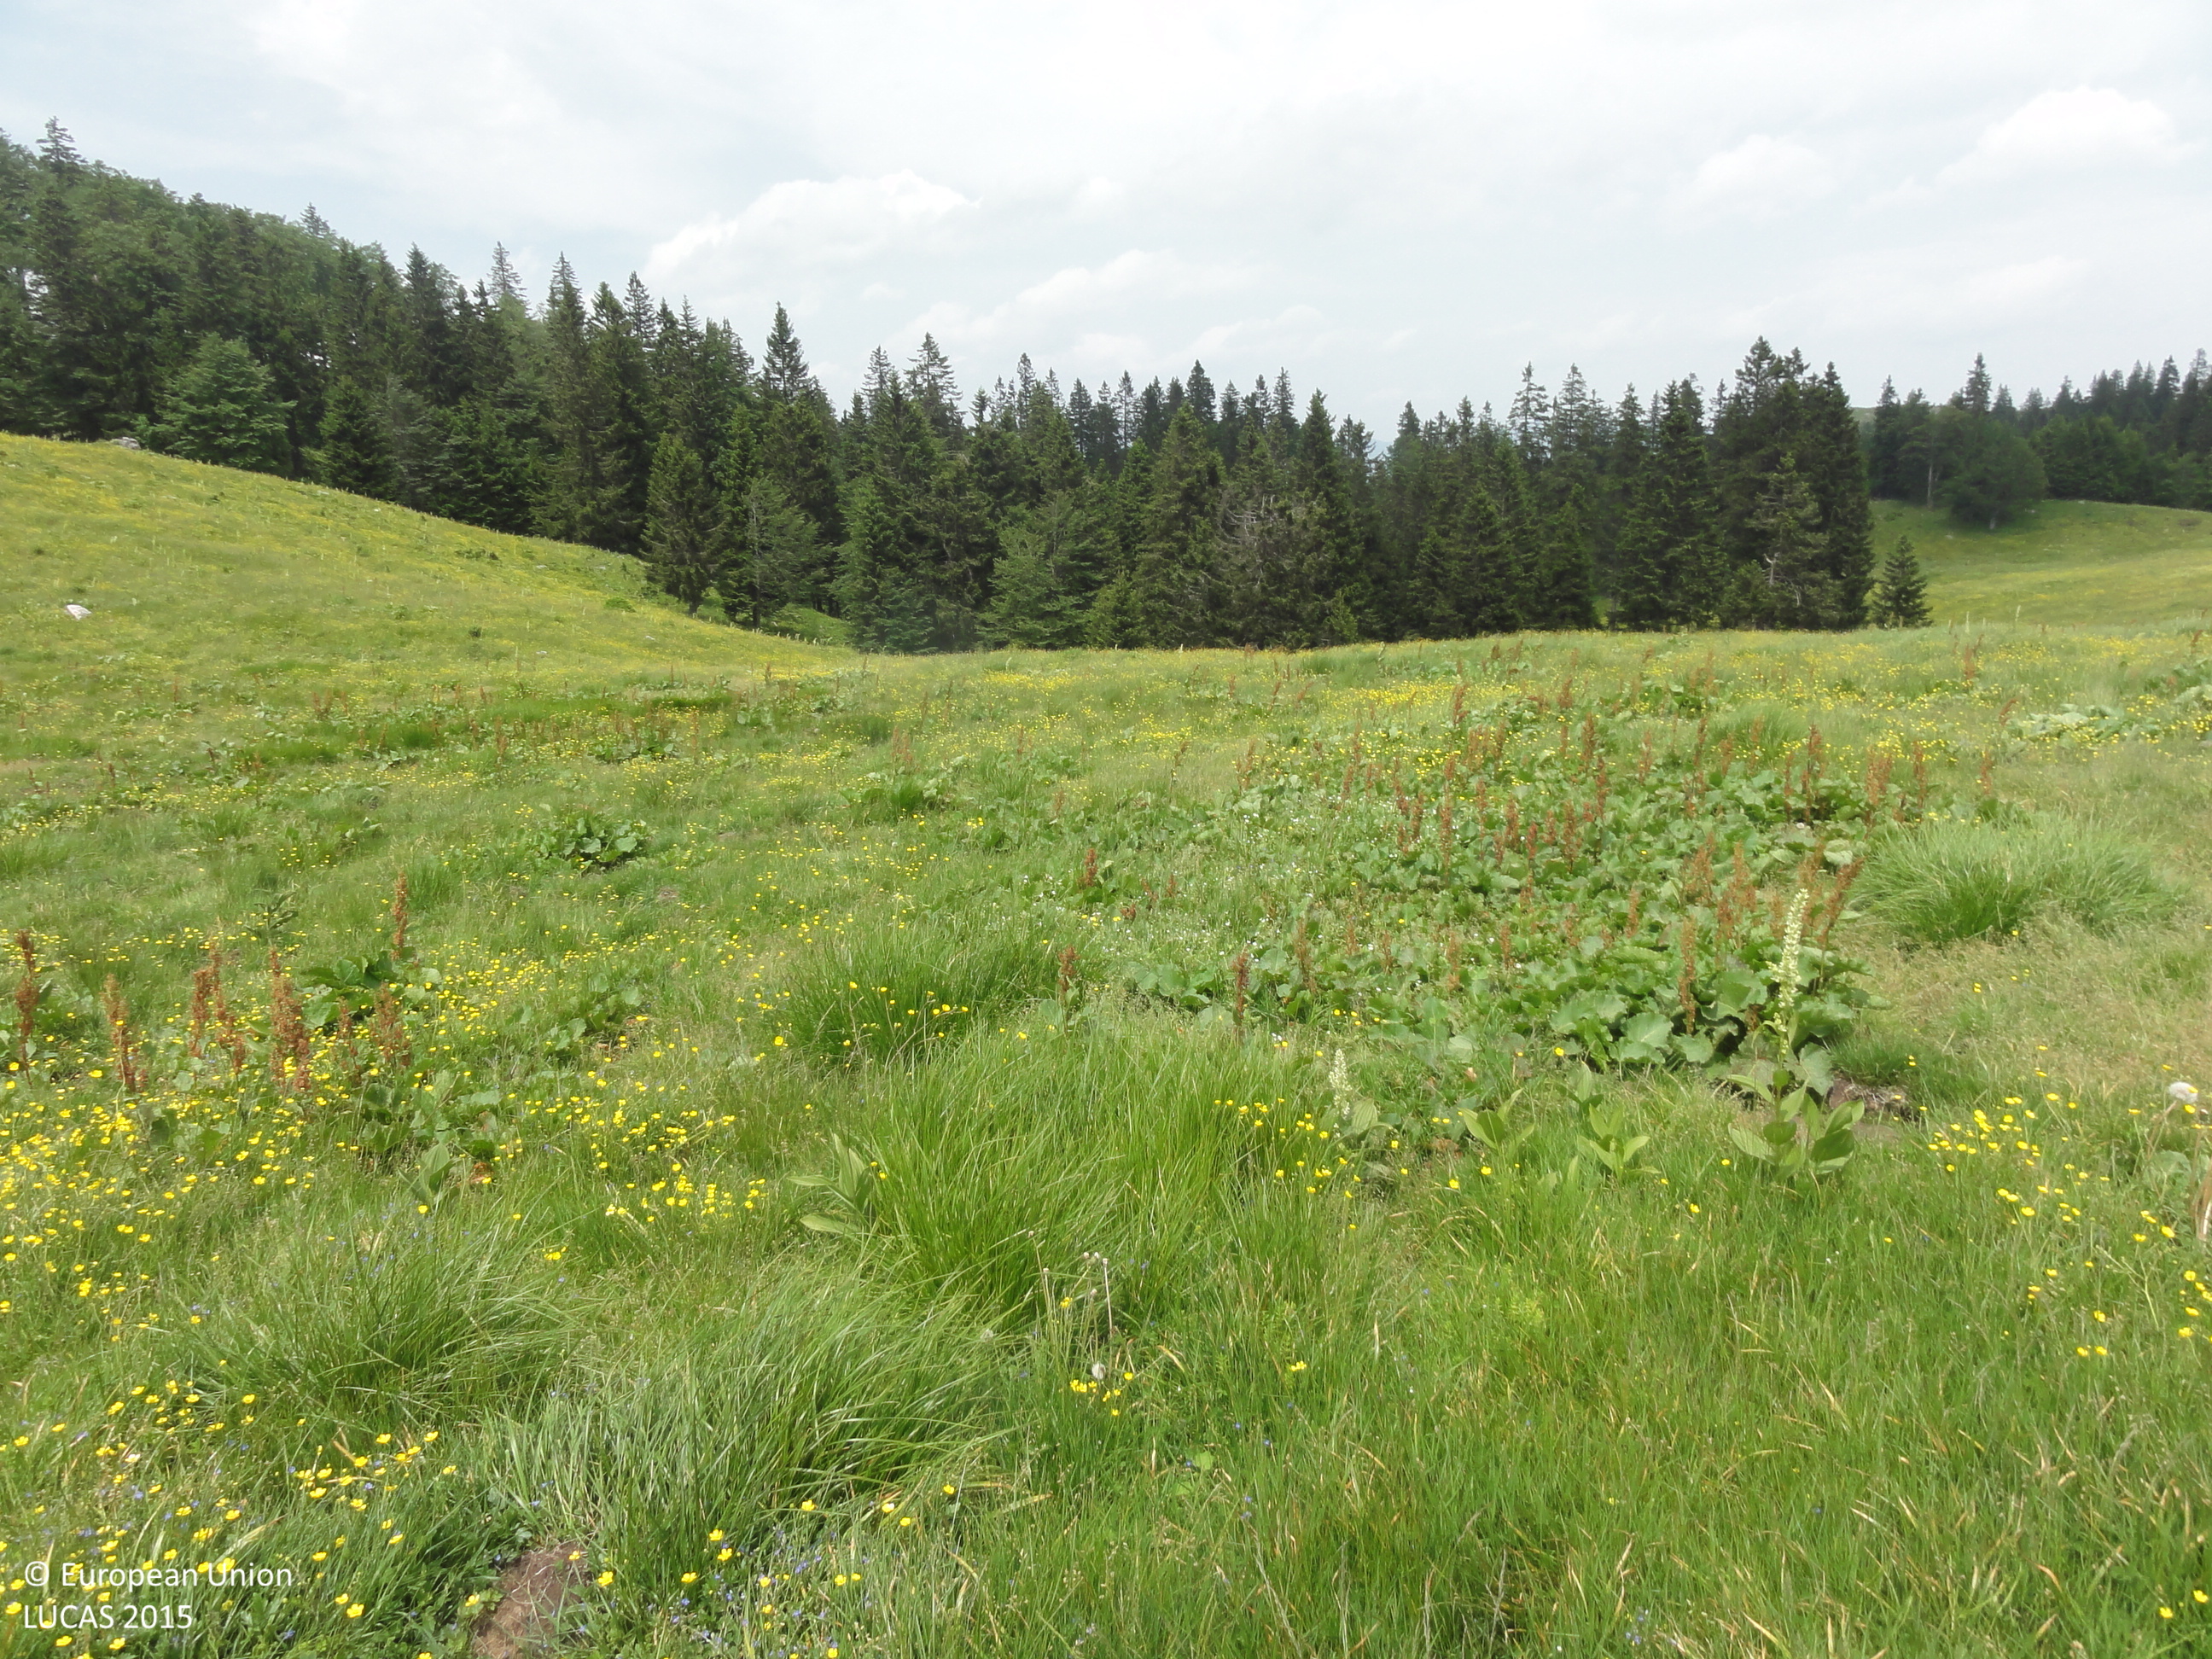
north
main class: Grassland
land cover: Grassland without tree/shrub cover
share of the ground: > 75 %
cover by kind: herbaceous plants 100 %
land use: Agriculture (excluding fallow land and kitchen gardens)
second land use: Amenities, museums, leisure
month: June
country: SI
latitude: 46.2611
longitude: 14.8104
